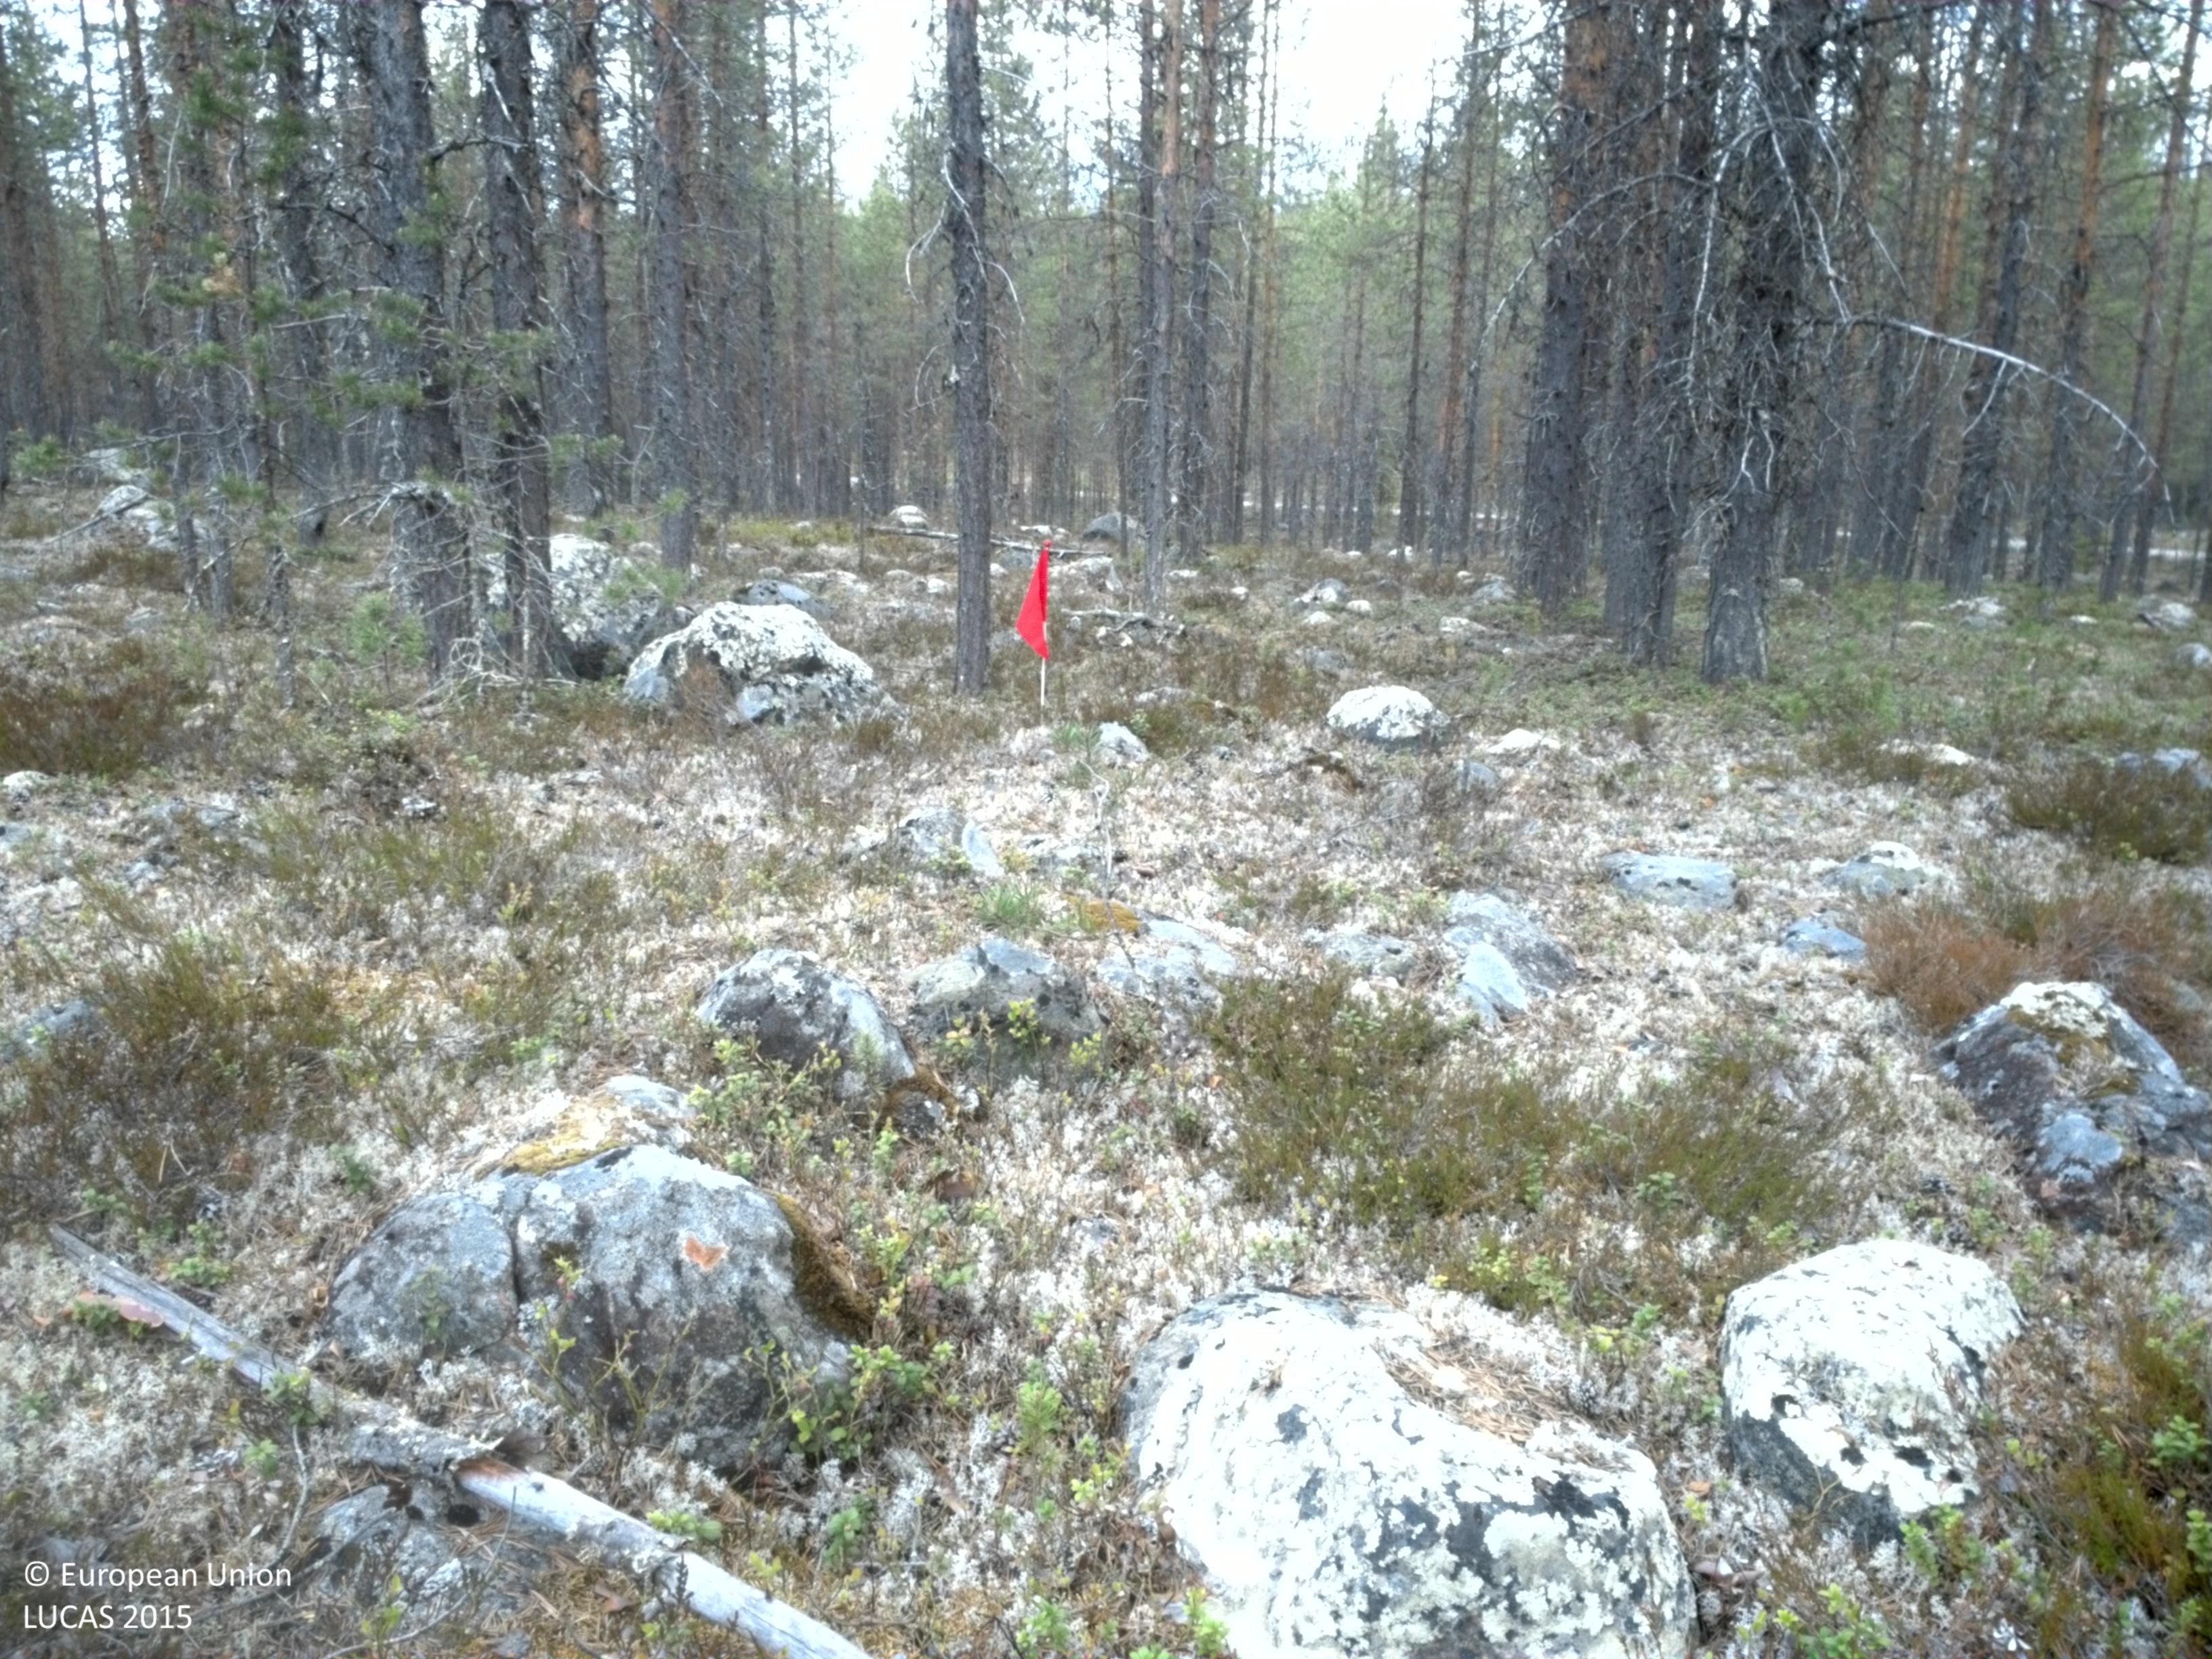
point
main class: Woodland
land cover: Pine dominated coniferous woodland
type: boreal forest
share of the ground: 25 - 50 %
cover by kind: shrubs 40 %, coniferous forest trees 35 %, lichens and mosses 20 %, consolidated bare surface 5 %
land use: Forestry
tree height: > 5 m
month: June
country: SE
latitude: 65.9196
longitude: 19.7772
